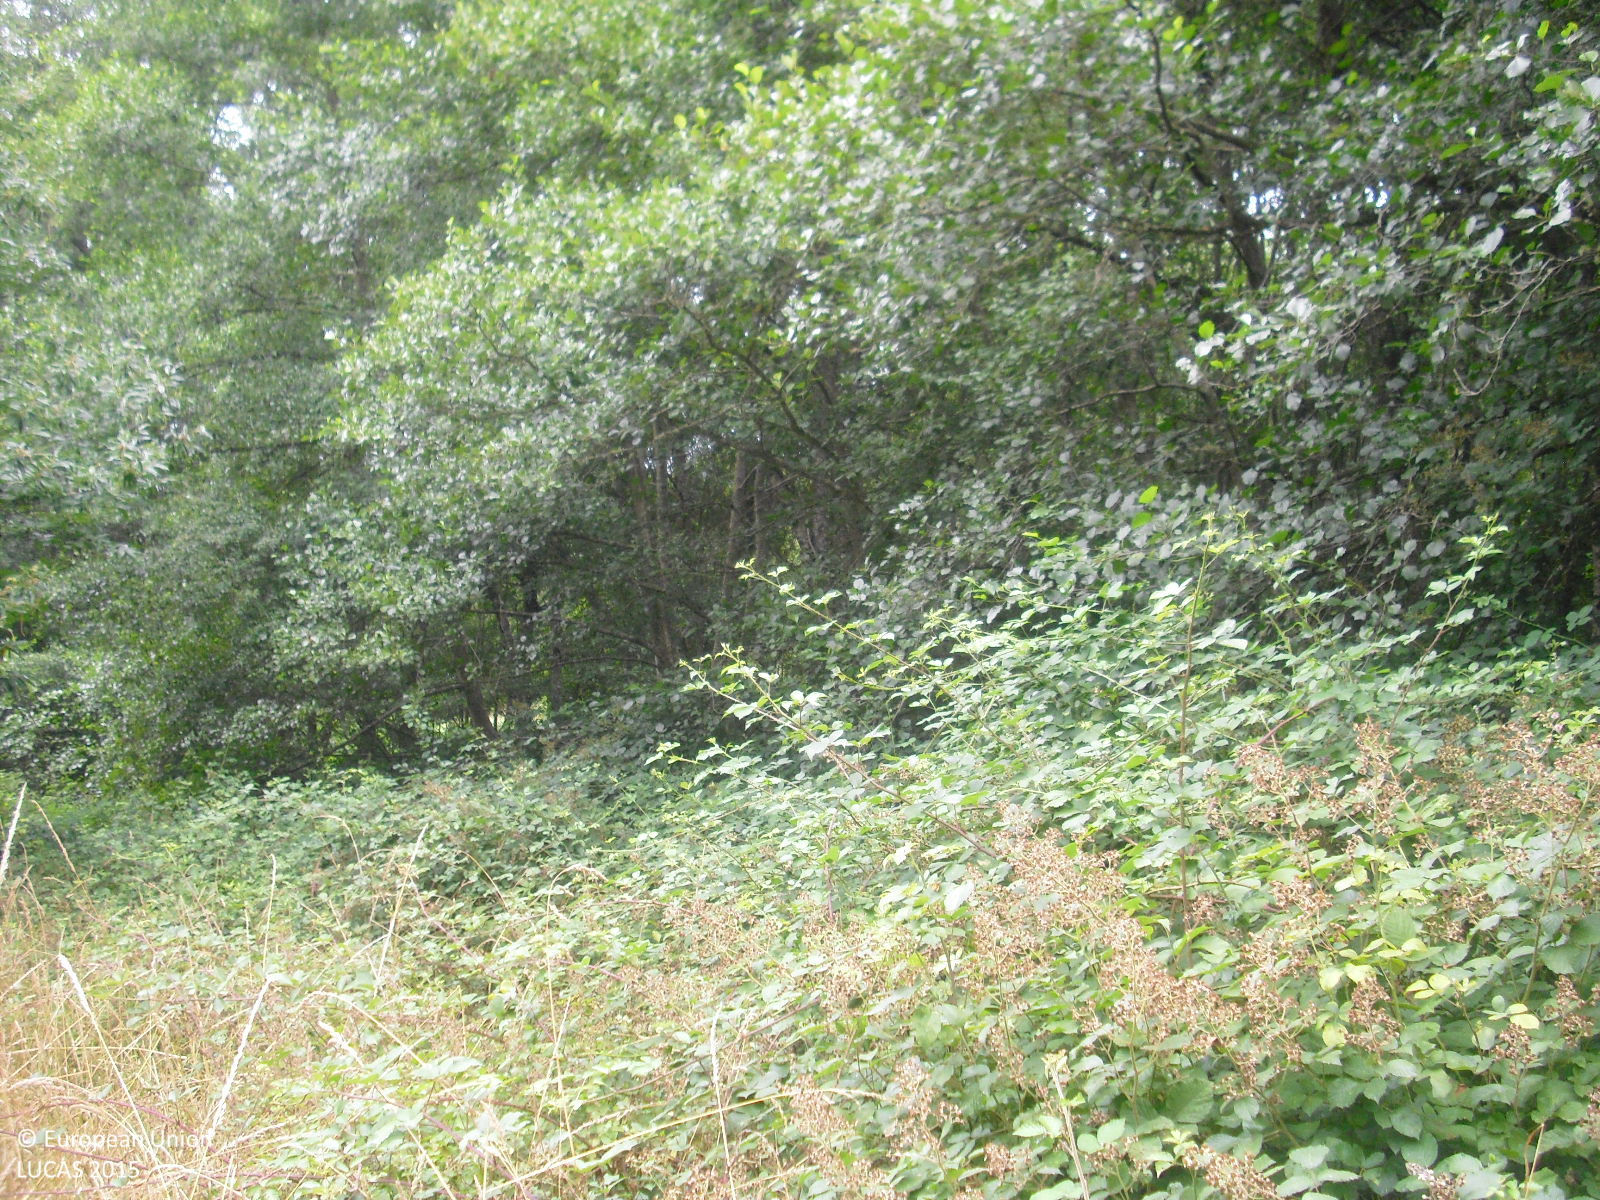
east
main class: Shrubland
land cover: Shrubland without tree cover
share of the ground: > 75 %
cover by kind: shrubs 70 %, herbaceous plants 30 %
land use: Abandoned areas
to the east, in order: Shrubland without tree cover; Broadleaved woodland; Rivers and streams; Broadleaved woodland; Grassland with sparse tree/shrub cover; Dry stone walls; Broadleaved woodland; Dry stone walls; Ditches and canals; Broadleaved woodland
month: July
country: ES
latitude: 42.3754
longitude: -7.4696
